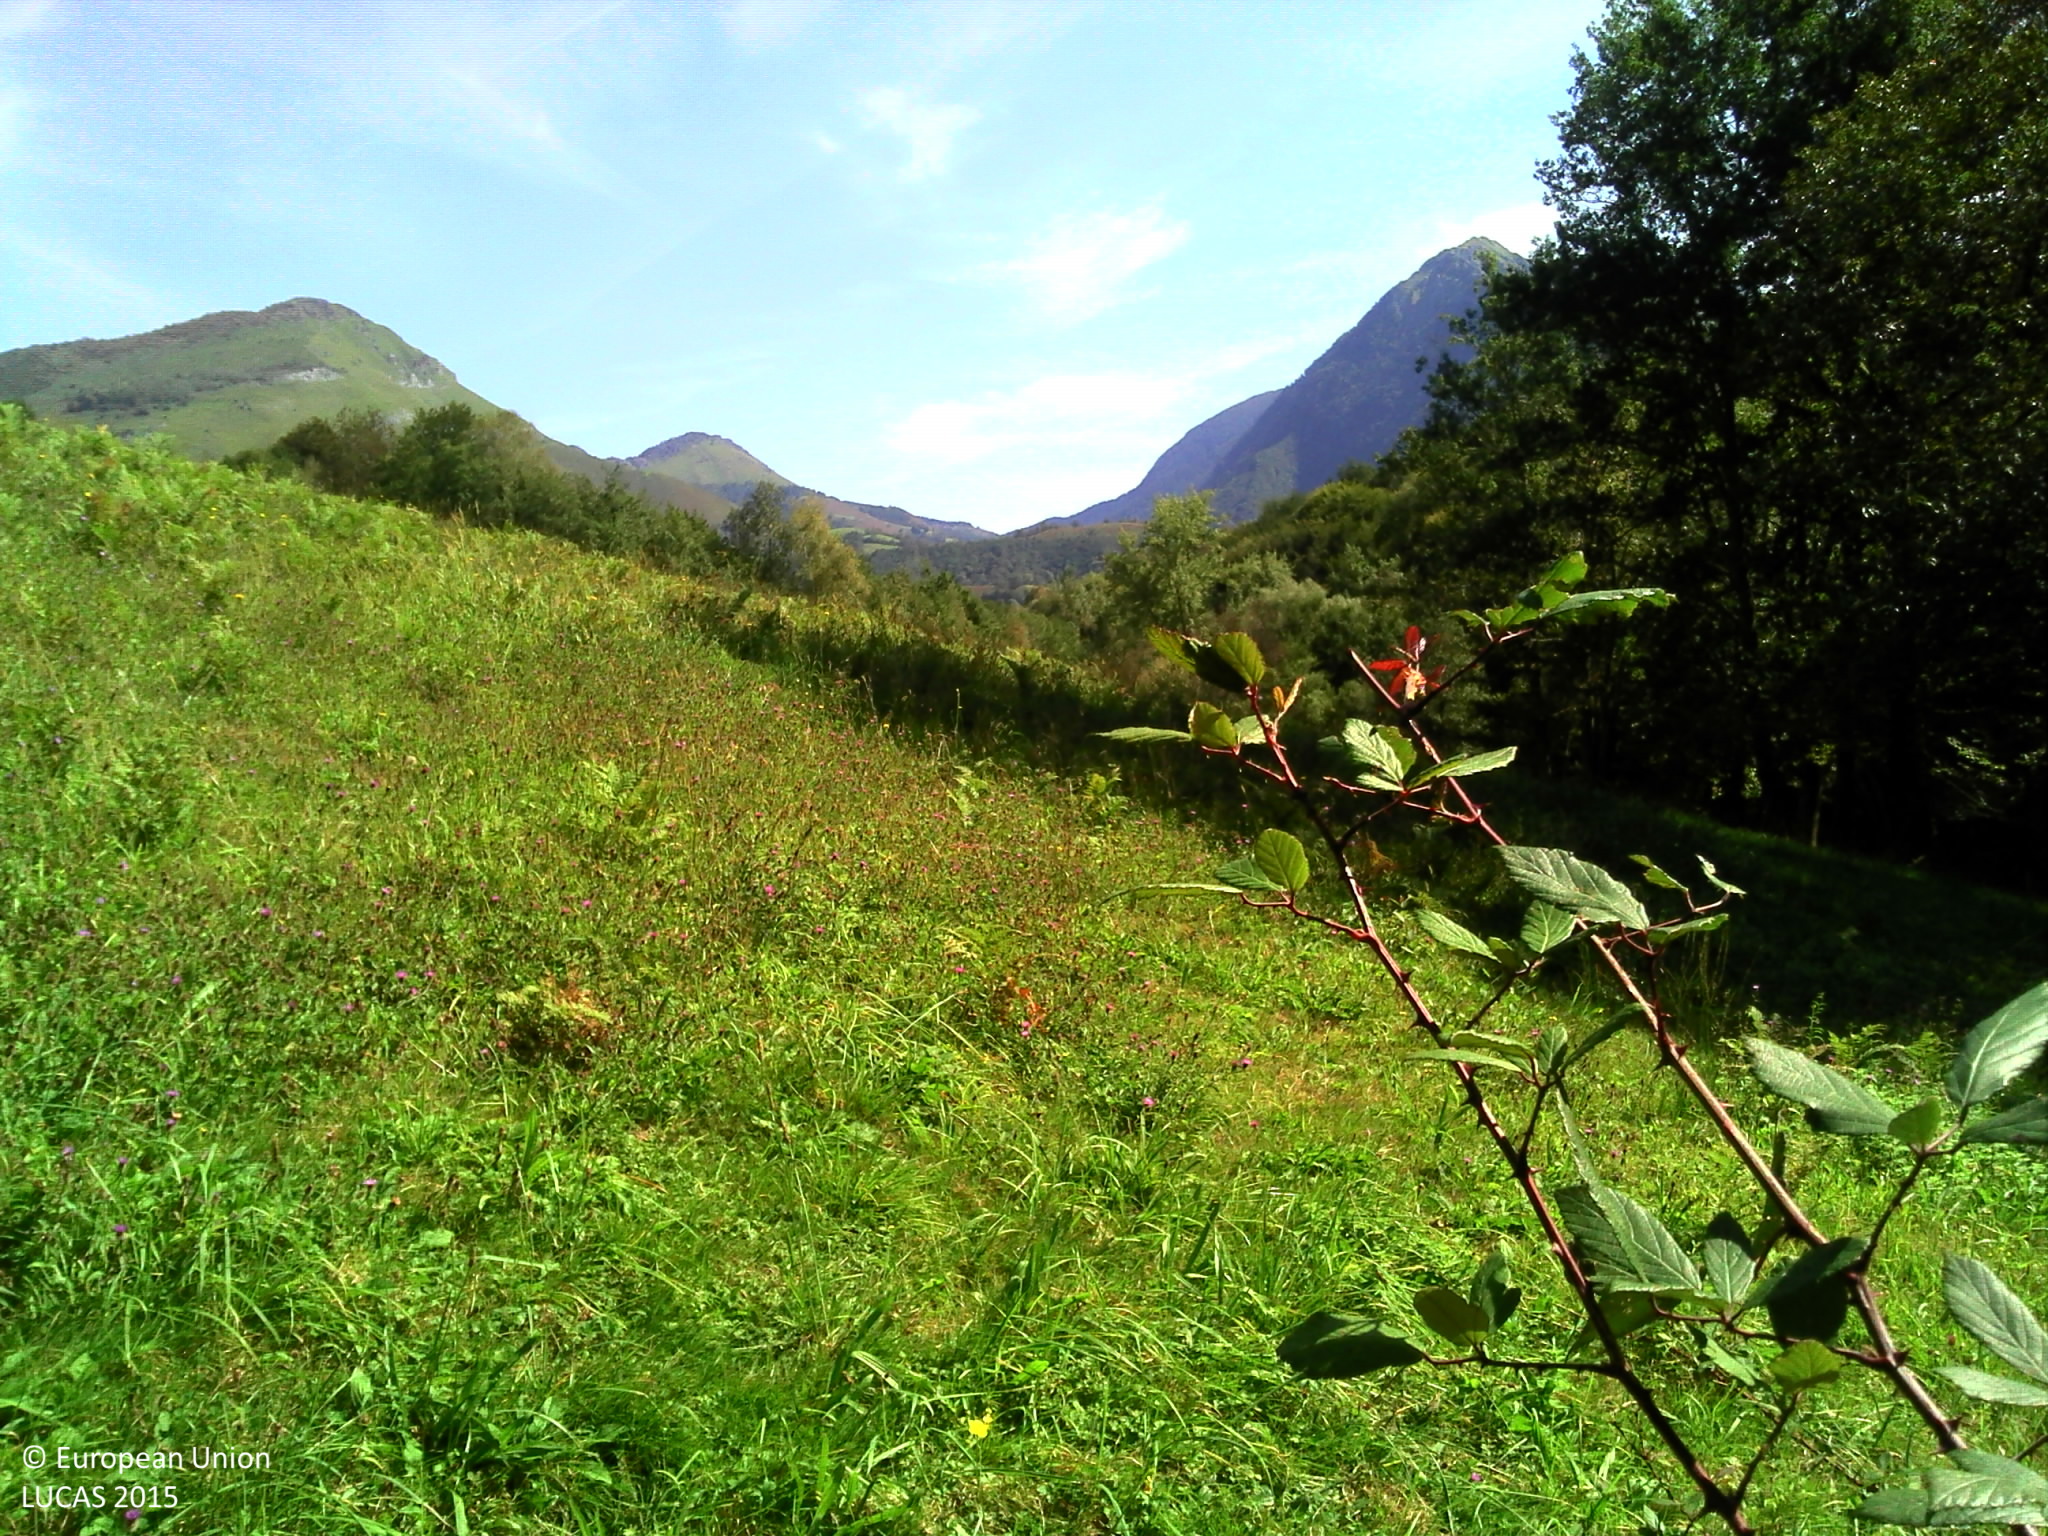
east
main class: Grassland
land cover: Grassland without tree/shrub cover
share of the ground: > 75 %
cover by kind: herbaceous plants 95 %, shrubs 5 %
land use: Agriculture (excluding fallow land and kitchen gardens)
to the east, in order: Grassland without tree/shrub cover; Fences; Spontaneously vegetated surfaces; Broadleaved woodland
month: September
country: FR
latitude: 43.0934
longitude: -0.6342
